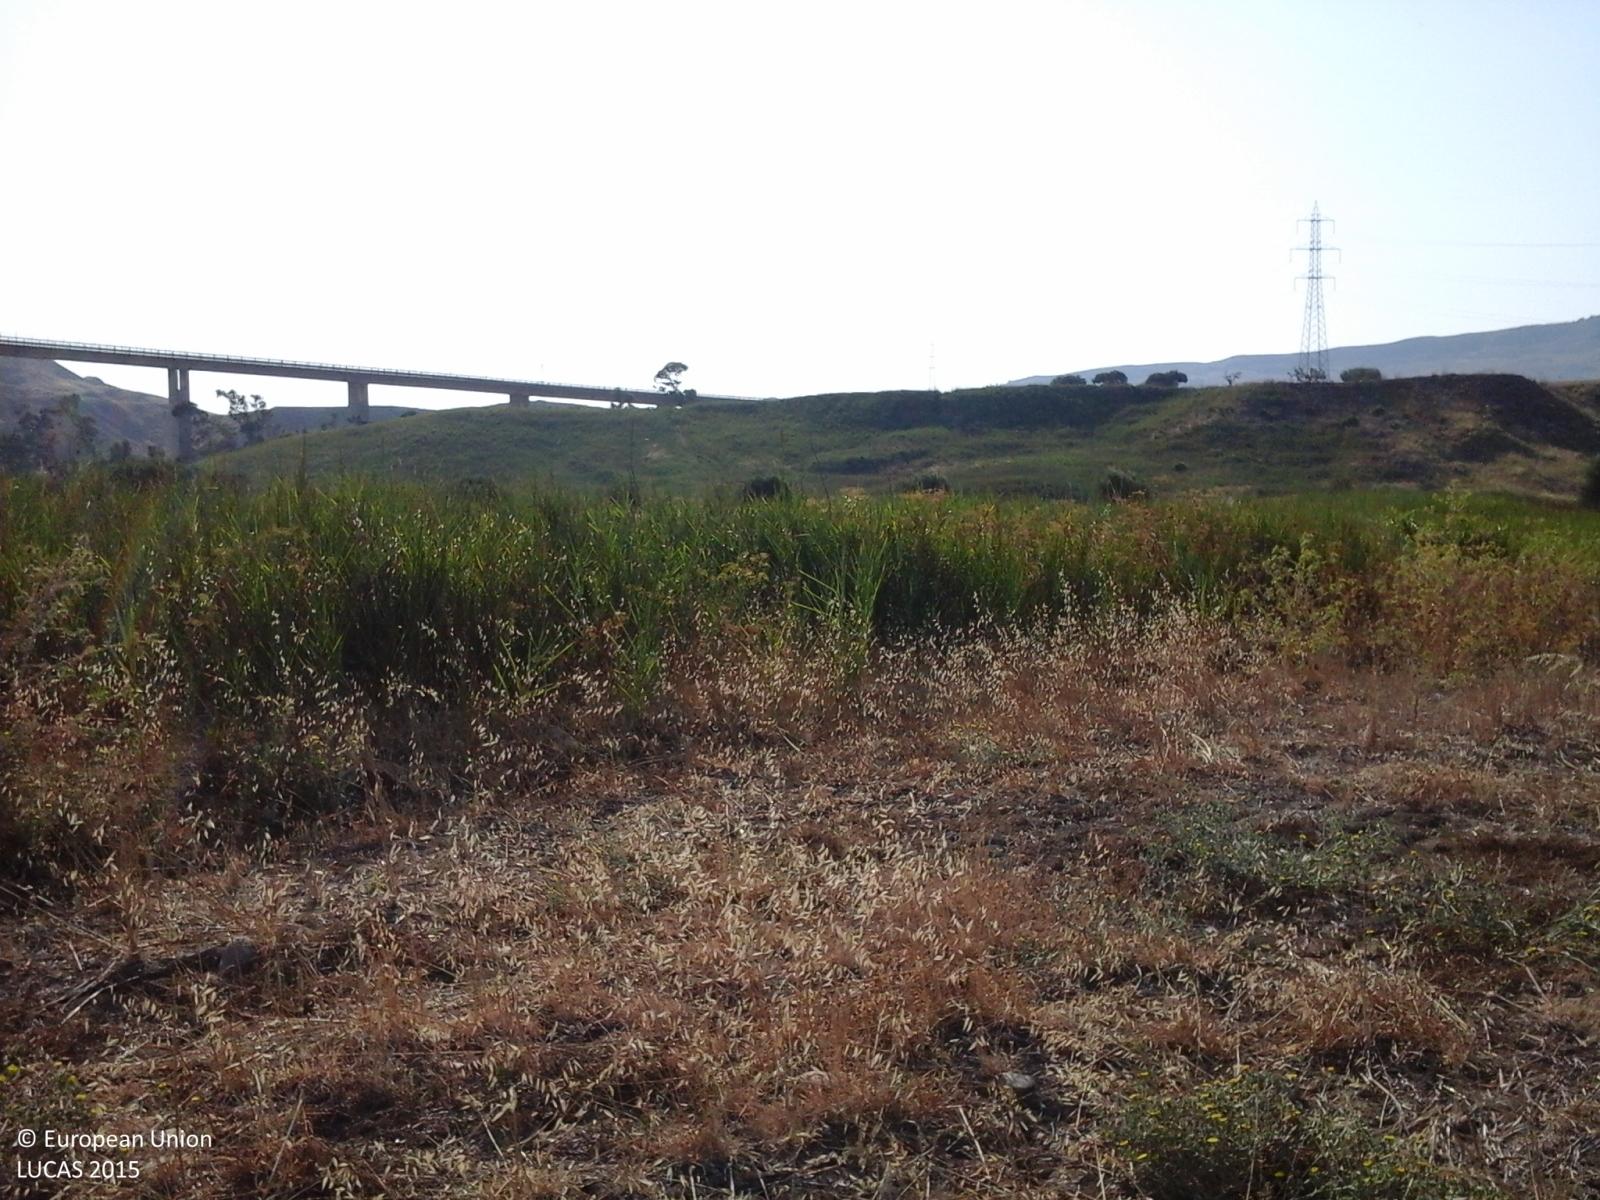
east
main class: Grassland
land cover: Spontaneously vegetated surfaces
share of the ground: > 75 %
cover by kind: herbaceous plants 100 %
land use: Agriculture (excluding fallow land and kitchen gardens)
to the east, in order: Spontaneously vegetated surfaces; Grassland without tree/shrub cover; Ditches and canals; Grassland without tree/shrub cover; Spontaneously vegetated surfaces; Electric lines; Olive groves; Grassland without tree/shrub cover; Inland fresh running water; Grassland without tree/shrub cover
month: July
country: IT
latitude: 37.1749
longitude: 13.9448
